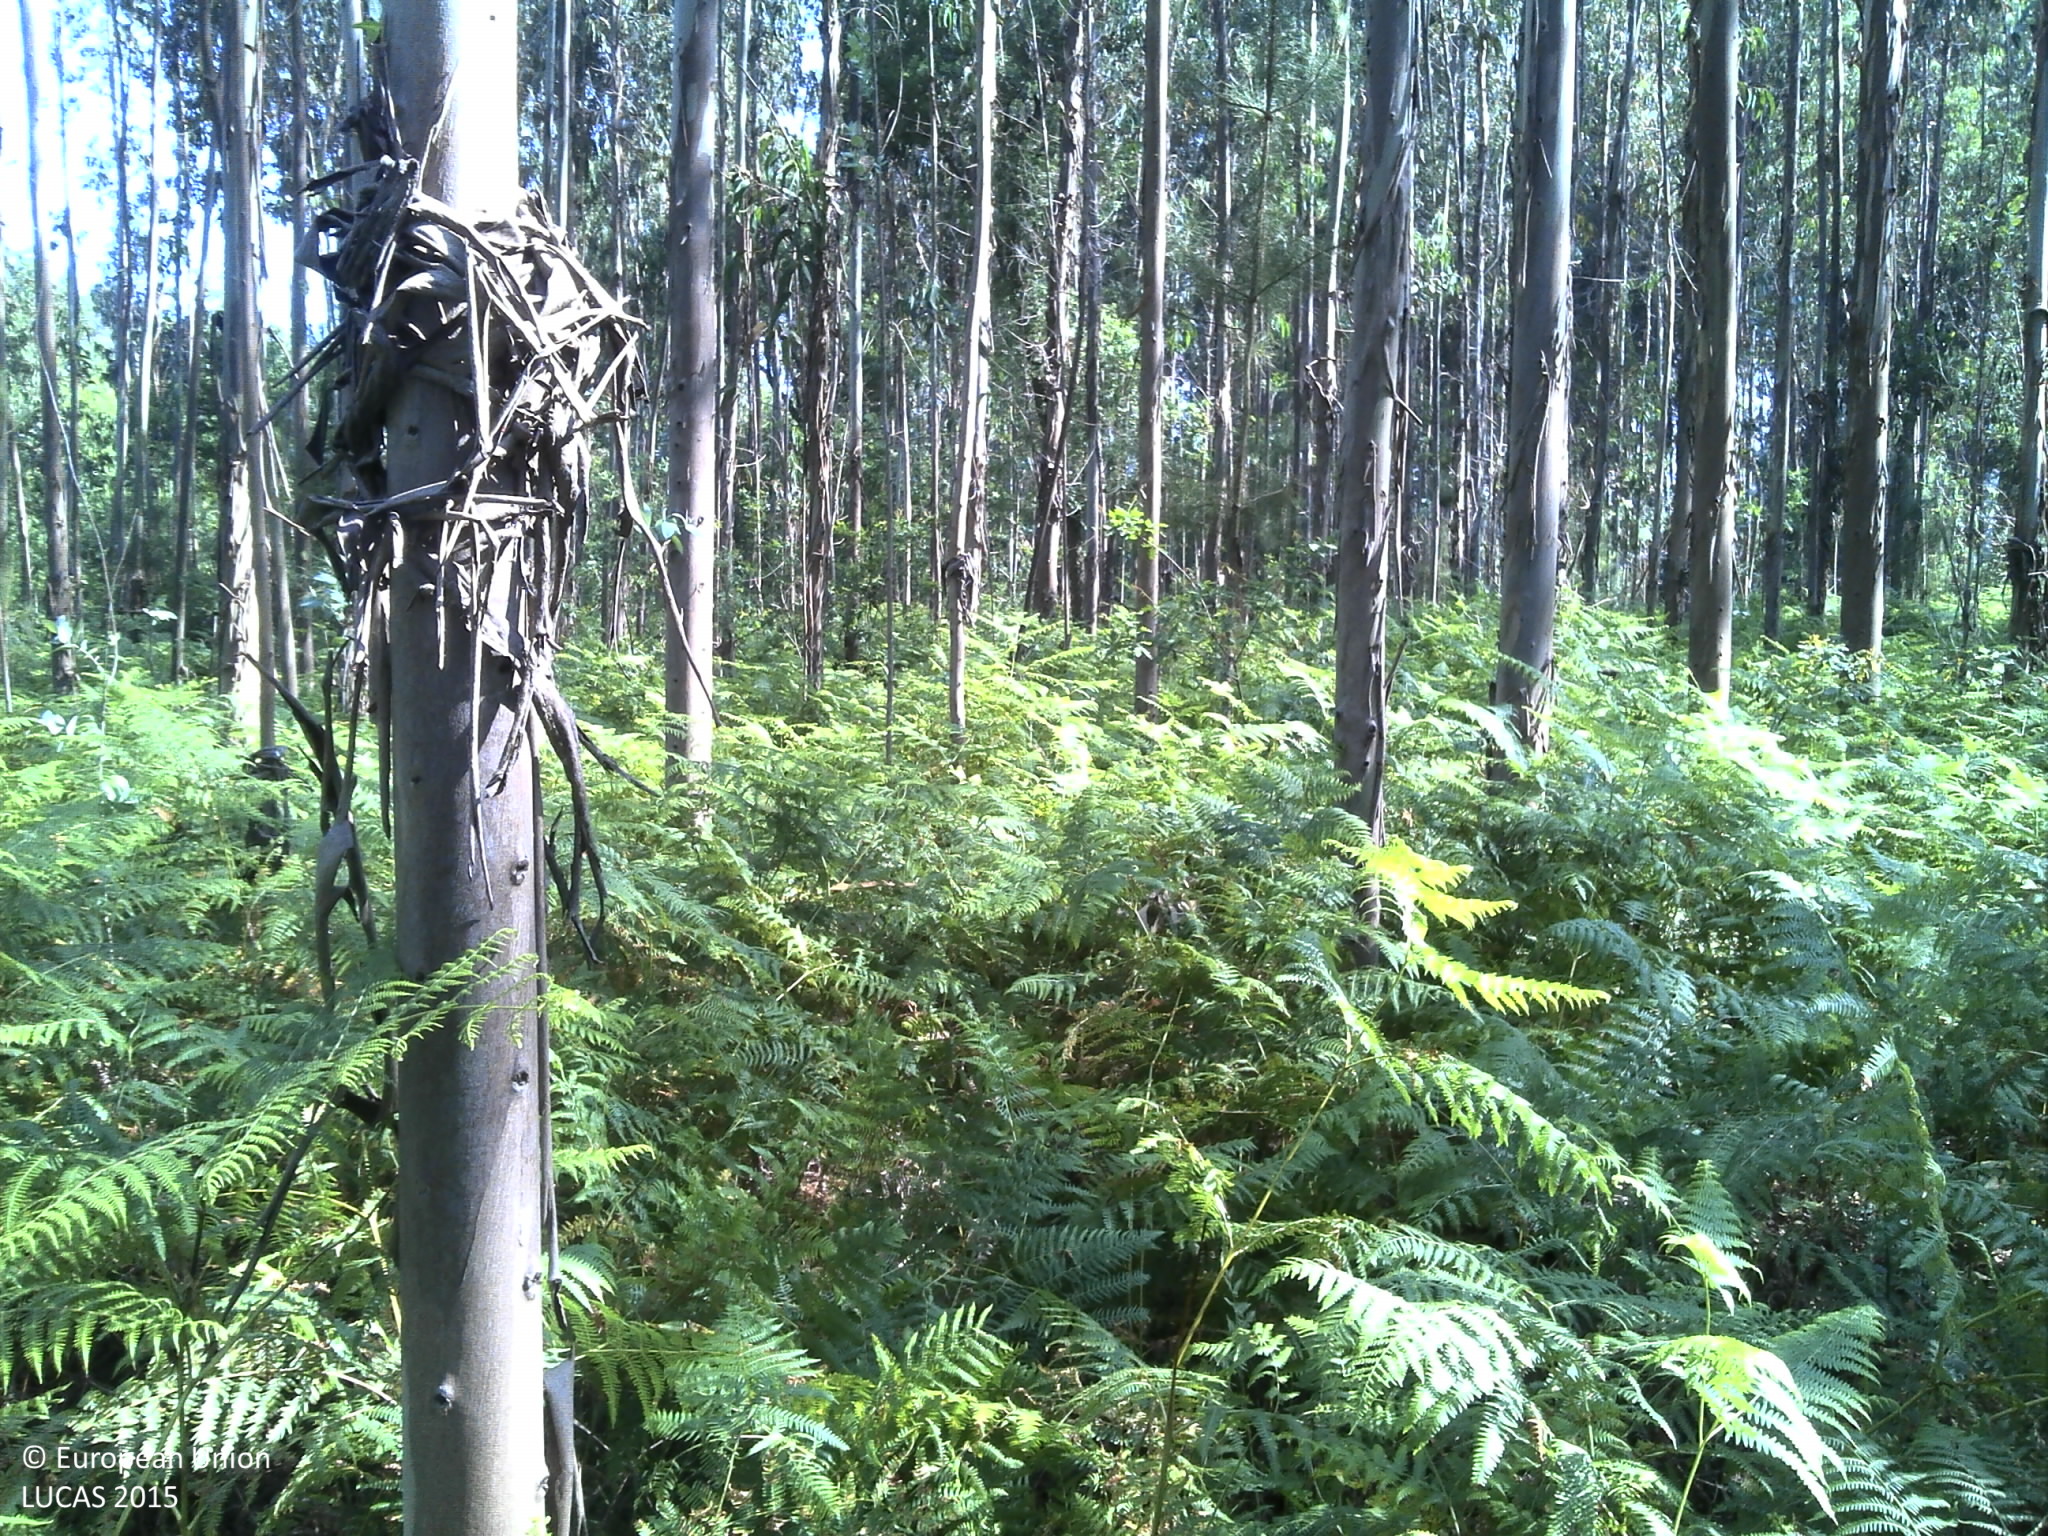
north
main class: Woodland
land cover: Broadleaved woodland
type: exotic forest
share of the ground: 50 - 75 %
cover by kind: broadleaved forest trees 70 %, shrubs 20 %, unconsolidated bare surface 10 %
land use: Forestry
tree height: > 5 m
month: June
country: PT
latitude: 40.8194
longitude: -8.5091
